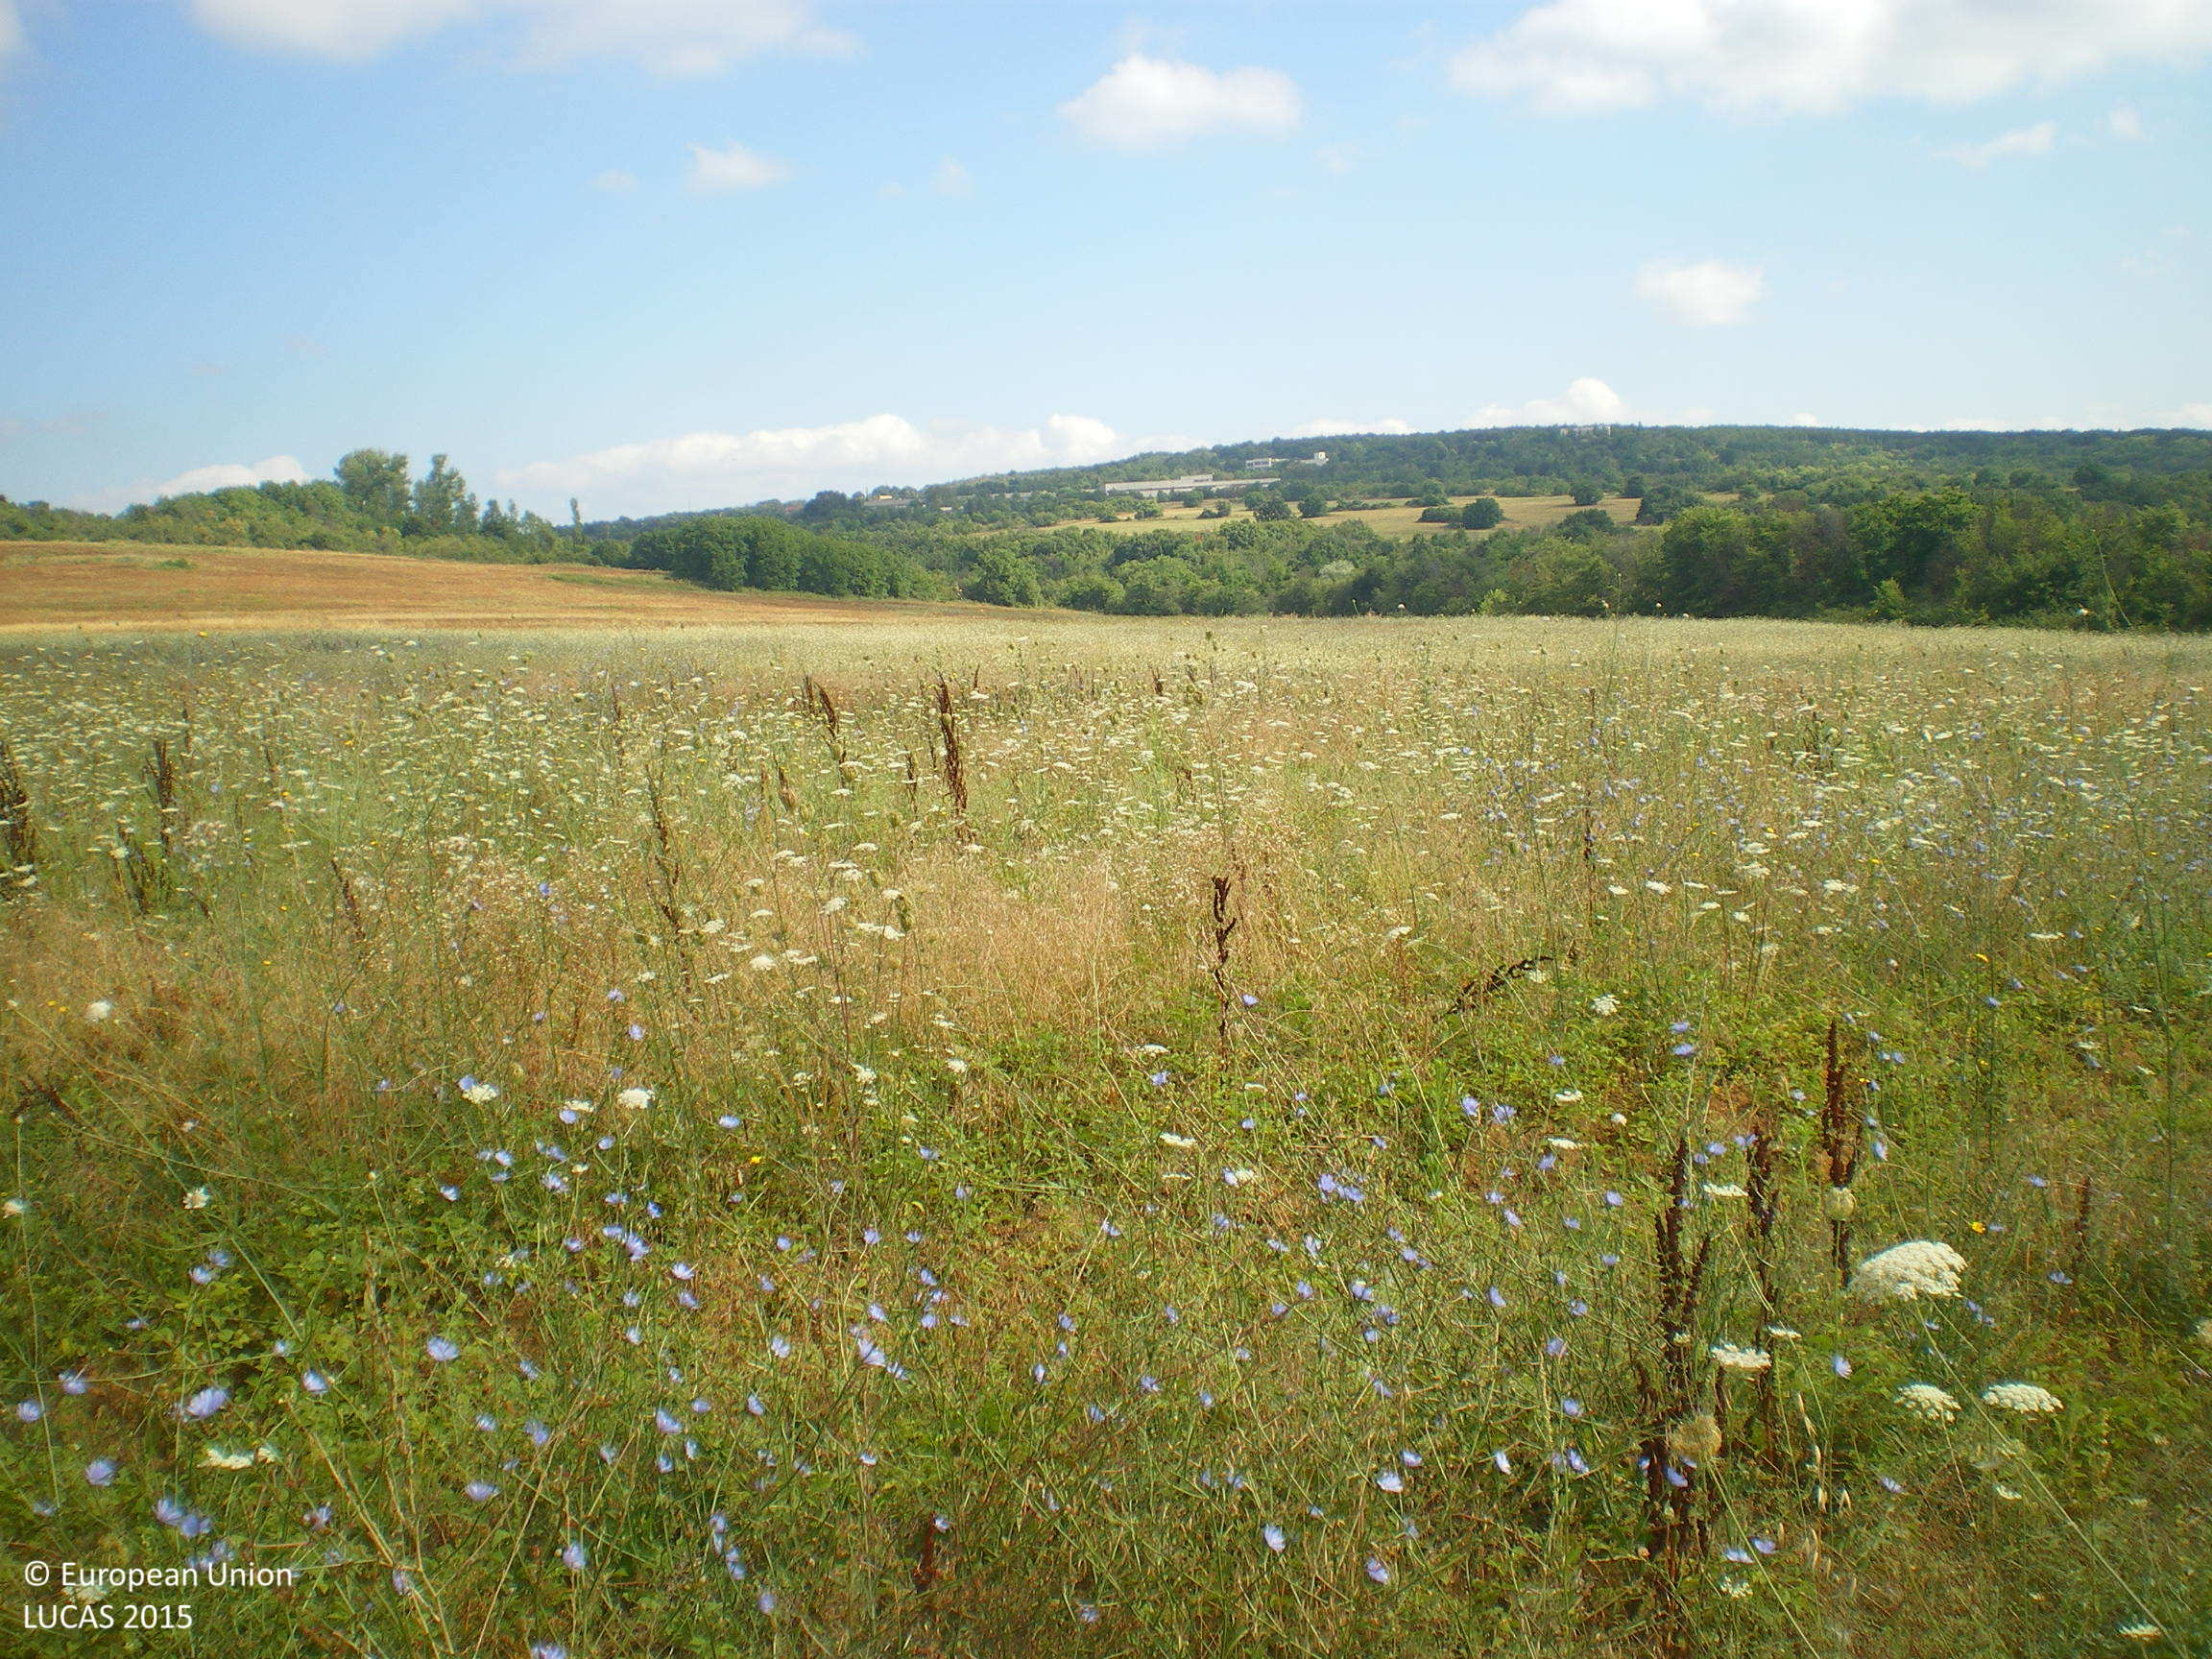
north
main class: Grassland
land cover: Spontaneously vegetated surfaces
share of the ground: > 75 %
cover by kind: herbaceous plants 100 %
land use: Fallow land
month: August
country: BG
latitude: 42.4857
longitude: 25.5830
